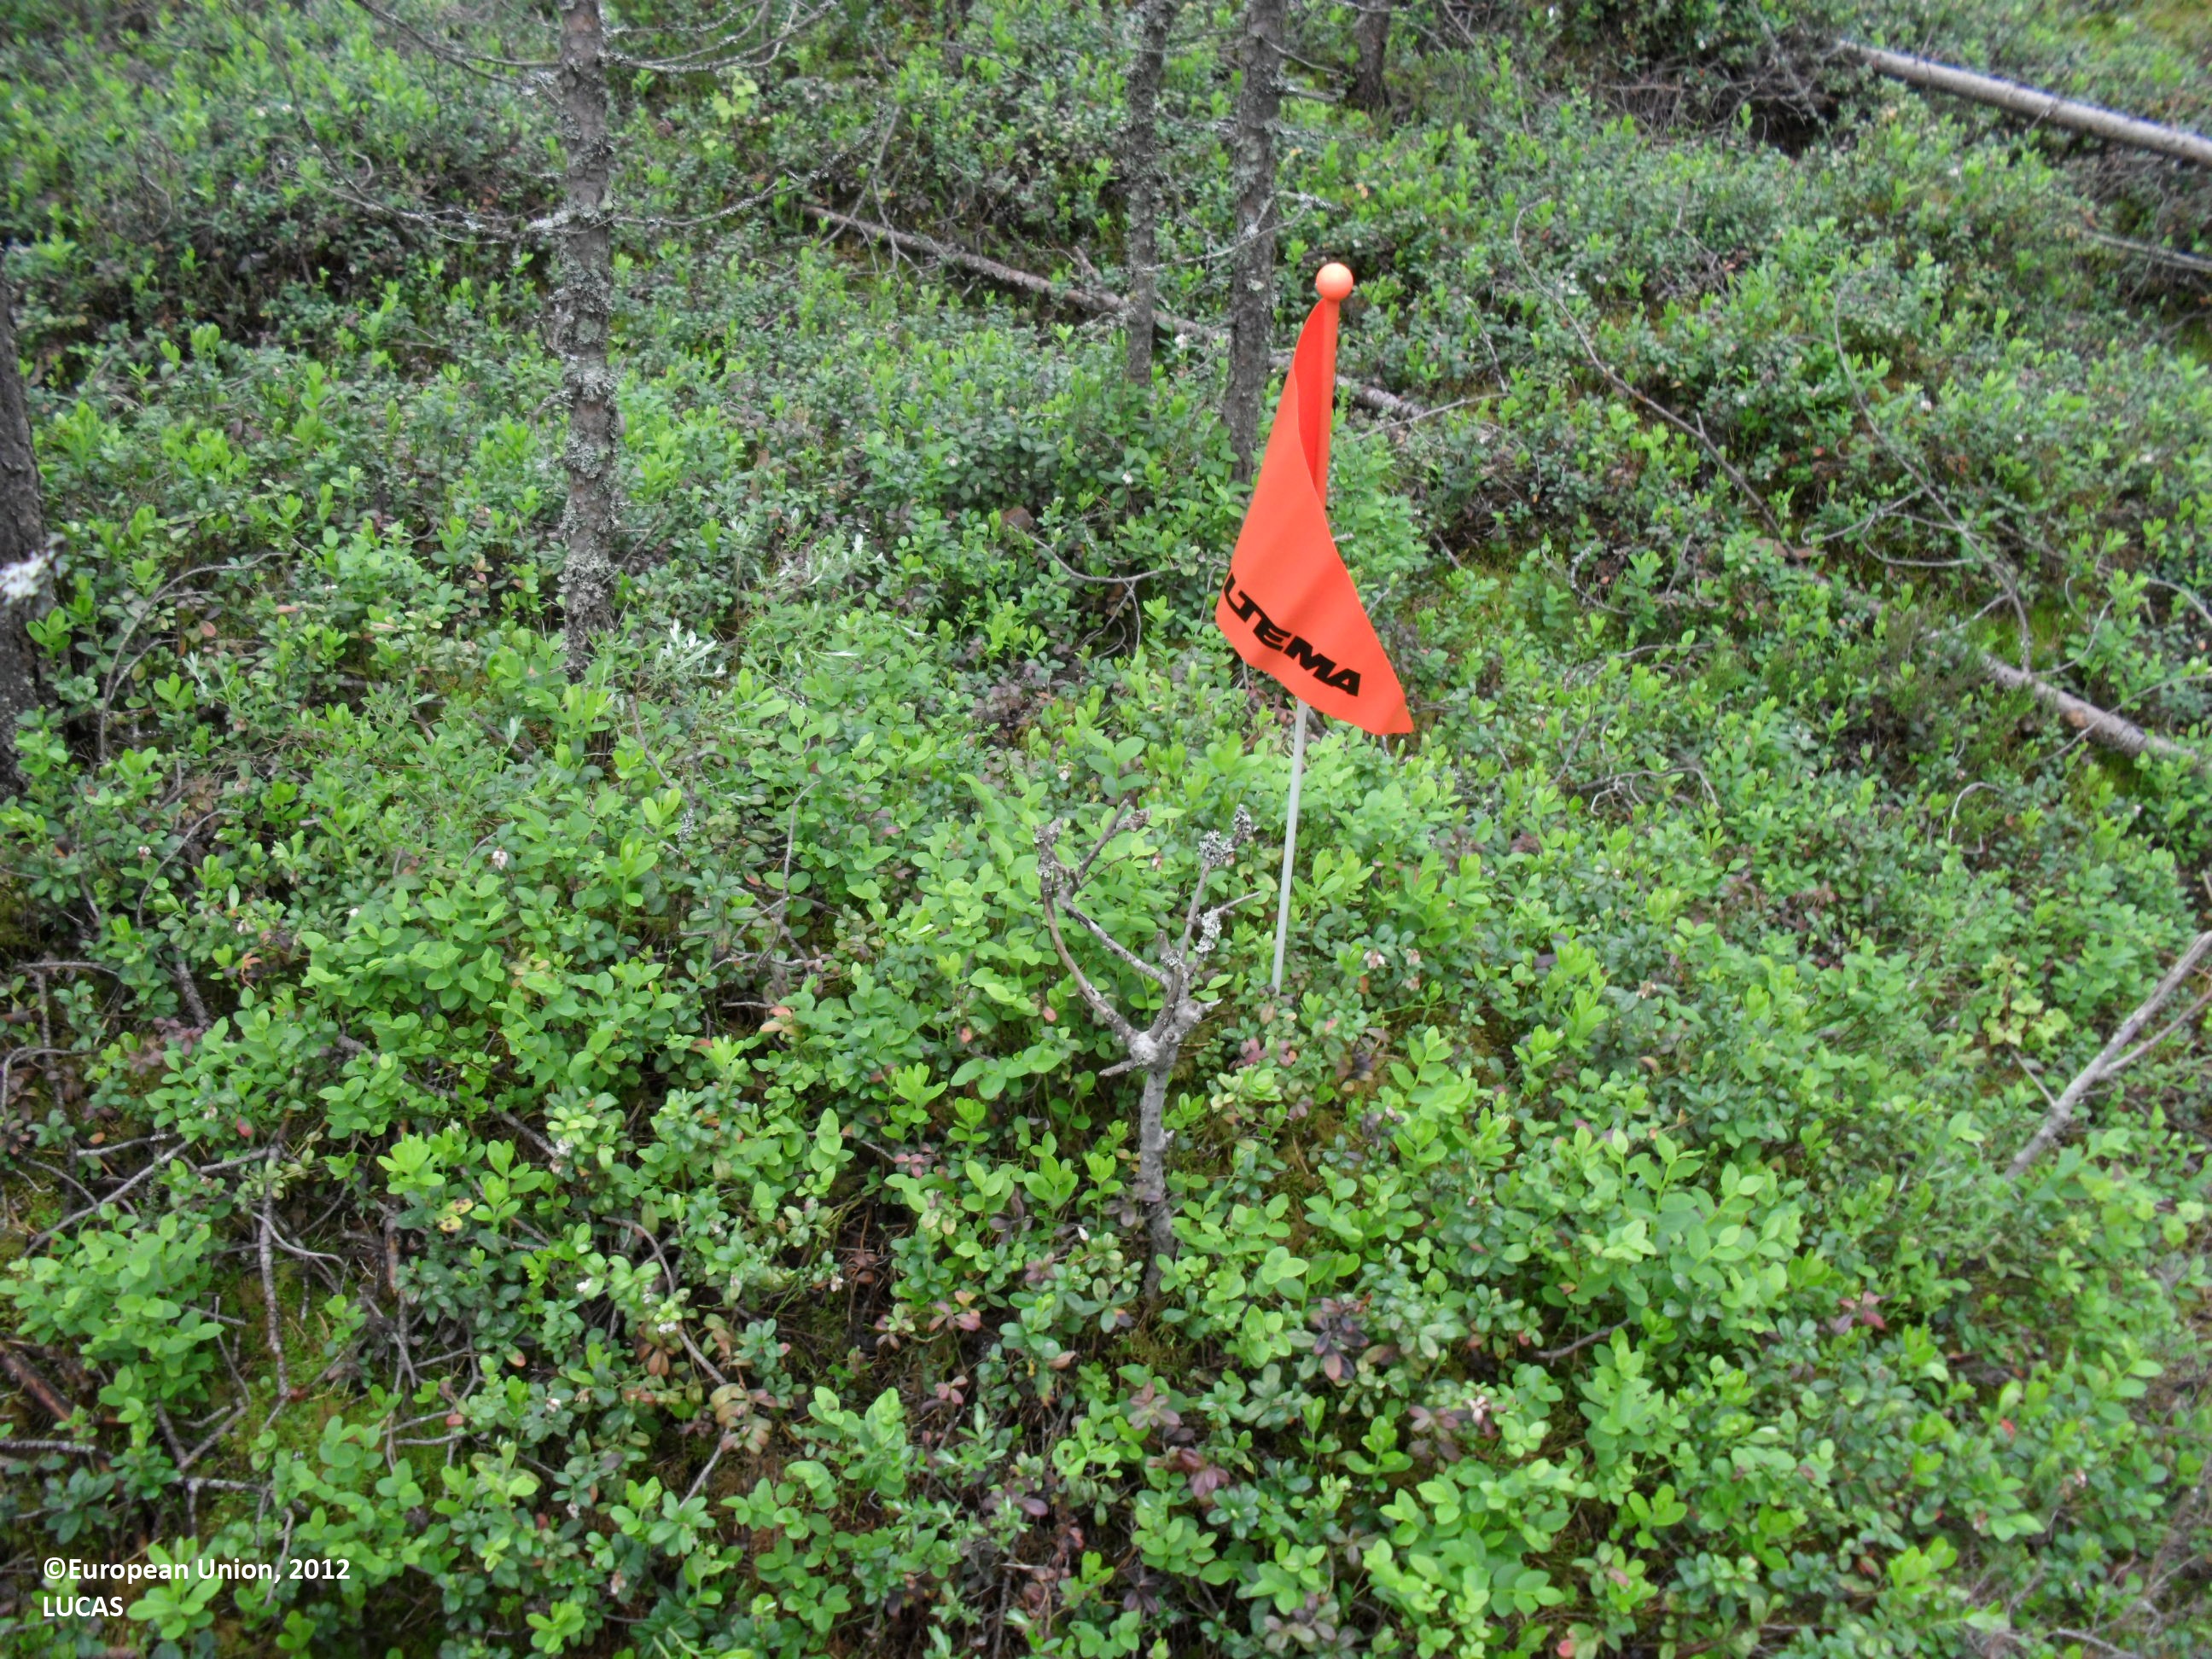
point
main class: Woodland
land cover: Pine dominated coniferous woodland
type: boreal forest
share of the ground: 50 - 75 %
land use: Forestry
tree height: > 5 m
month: June
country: FI
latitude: 63.1947
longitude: 23.2788
